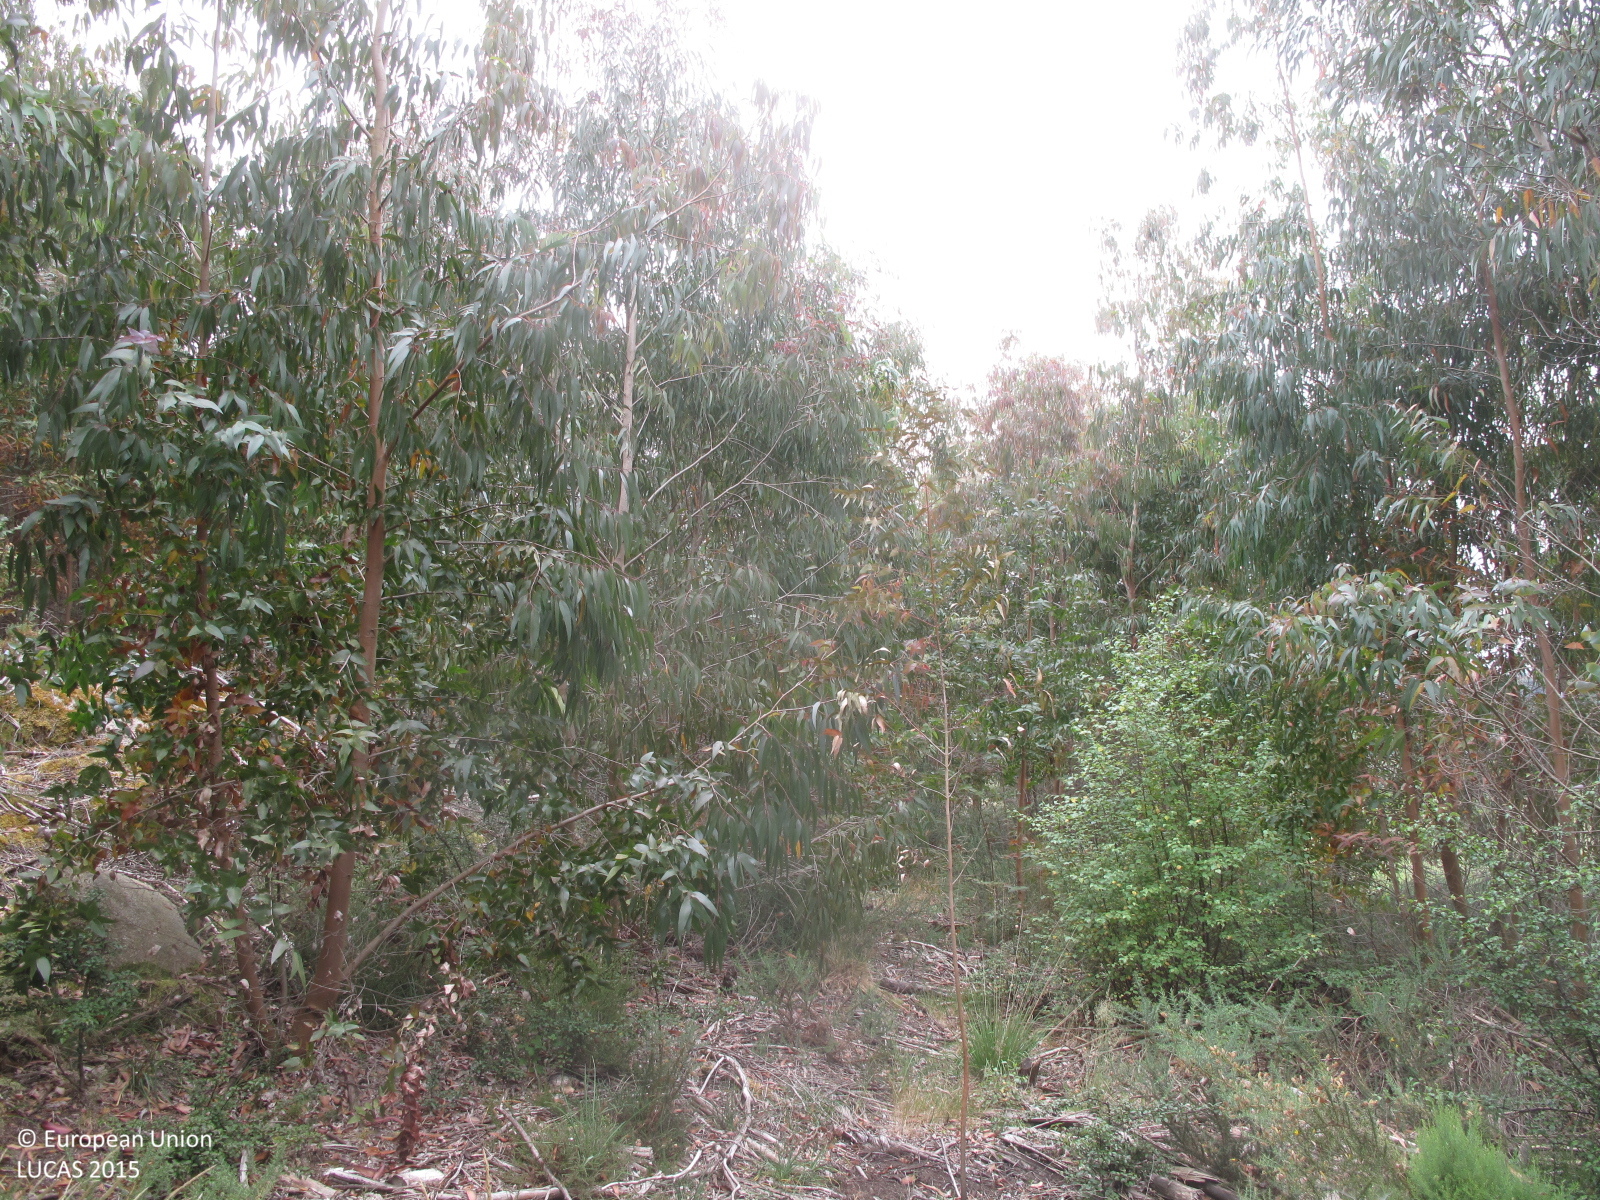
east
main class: Woodland
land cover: Broadleaved woodland
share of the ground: 50 - 75 %
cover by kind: broadleaved forest trees 70 %, shrubs 10 %, herbaceous plants 10 %, unconsolidated bare surface 10 %
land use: Forestry
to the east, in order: Broadleaved woodland; Grassland without tree/shrub cover; Maize; Shruby margins; Maize; Shruby margins; Tracks; Shruby margins; Fences; Maize
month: June
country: ES
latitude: 43.1643
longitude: -8.1142
